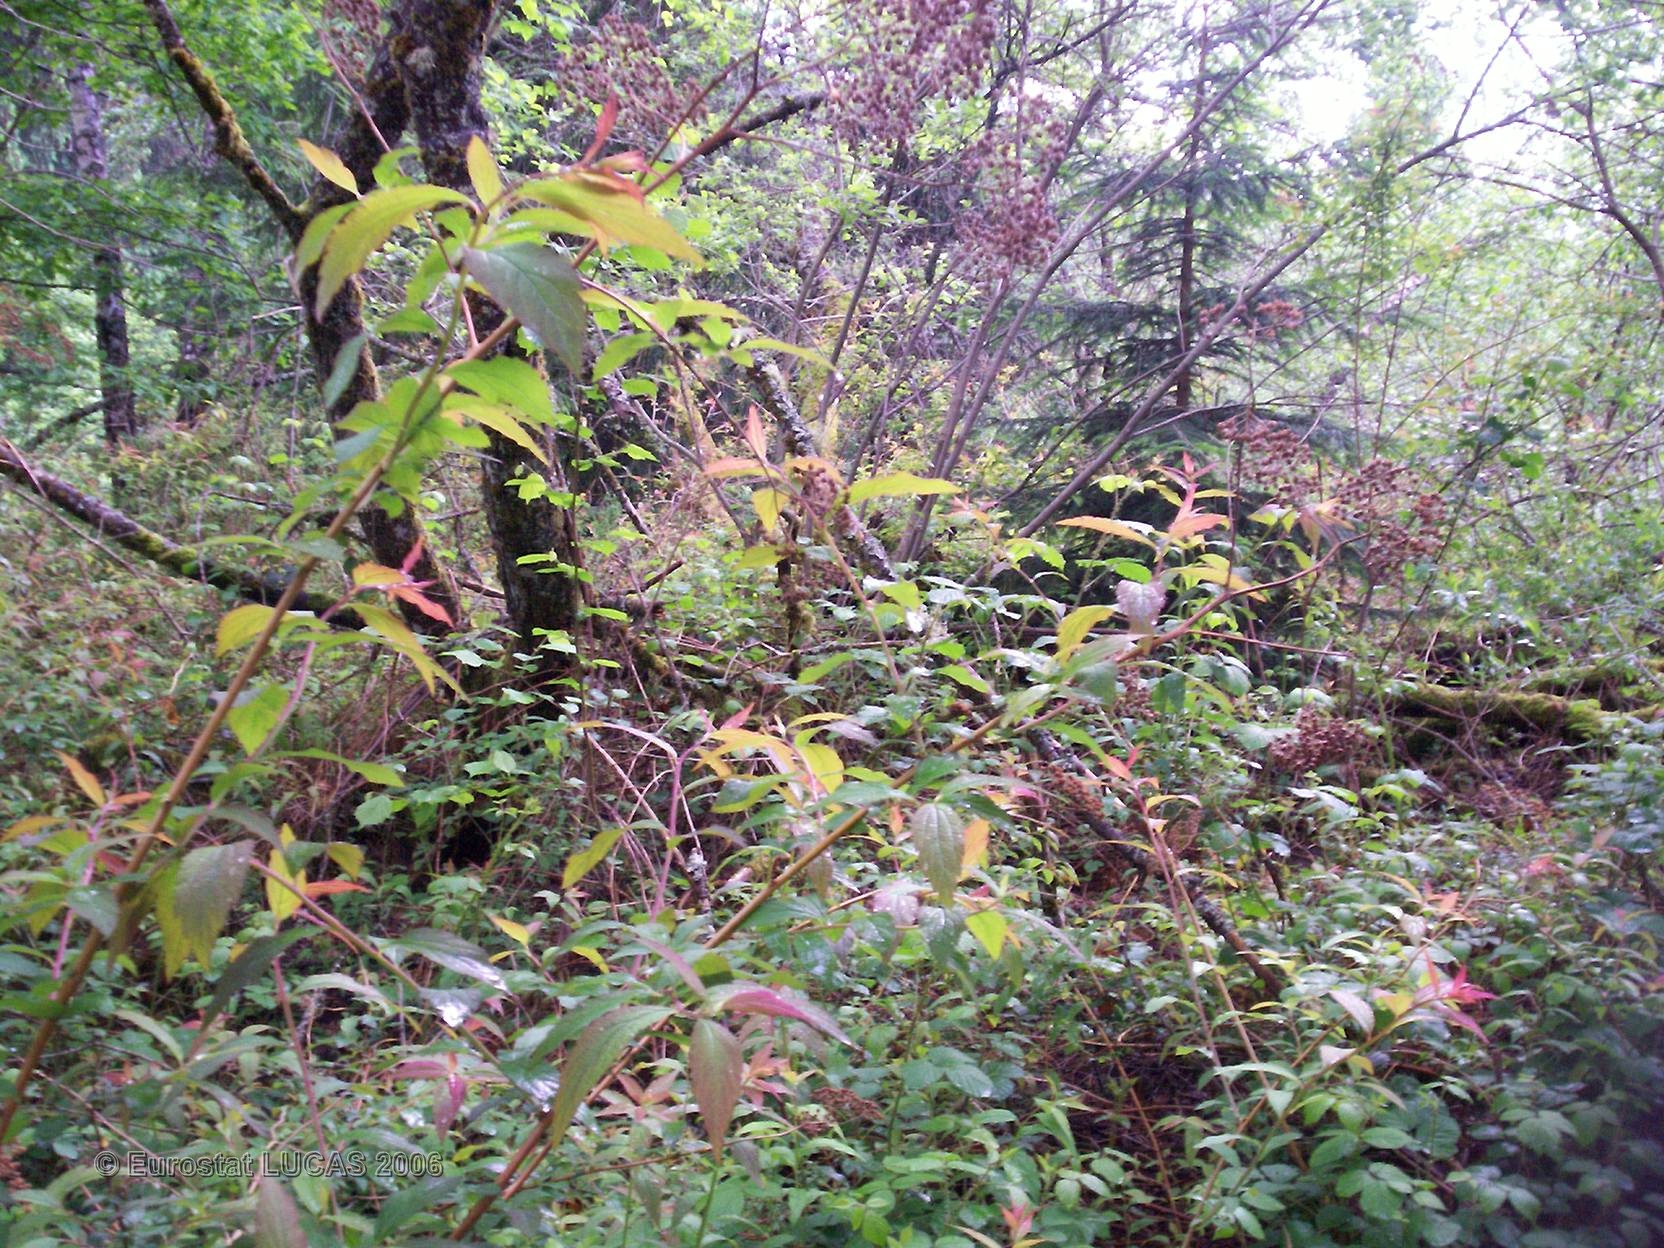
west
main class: Woodland
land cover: Broadleaved forest
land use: Unused
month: June
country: FR
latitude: 47.9423
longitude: 6.7747
